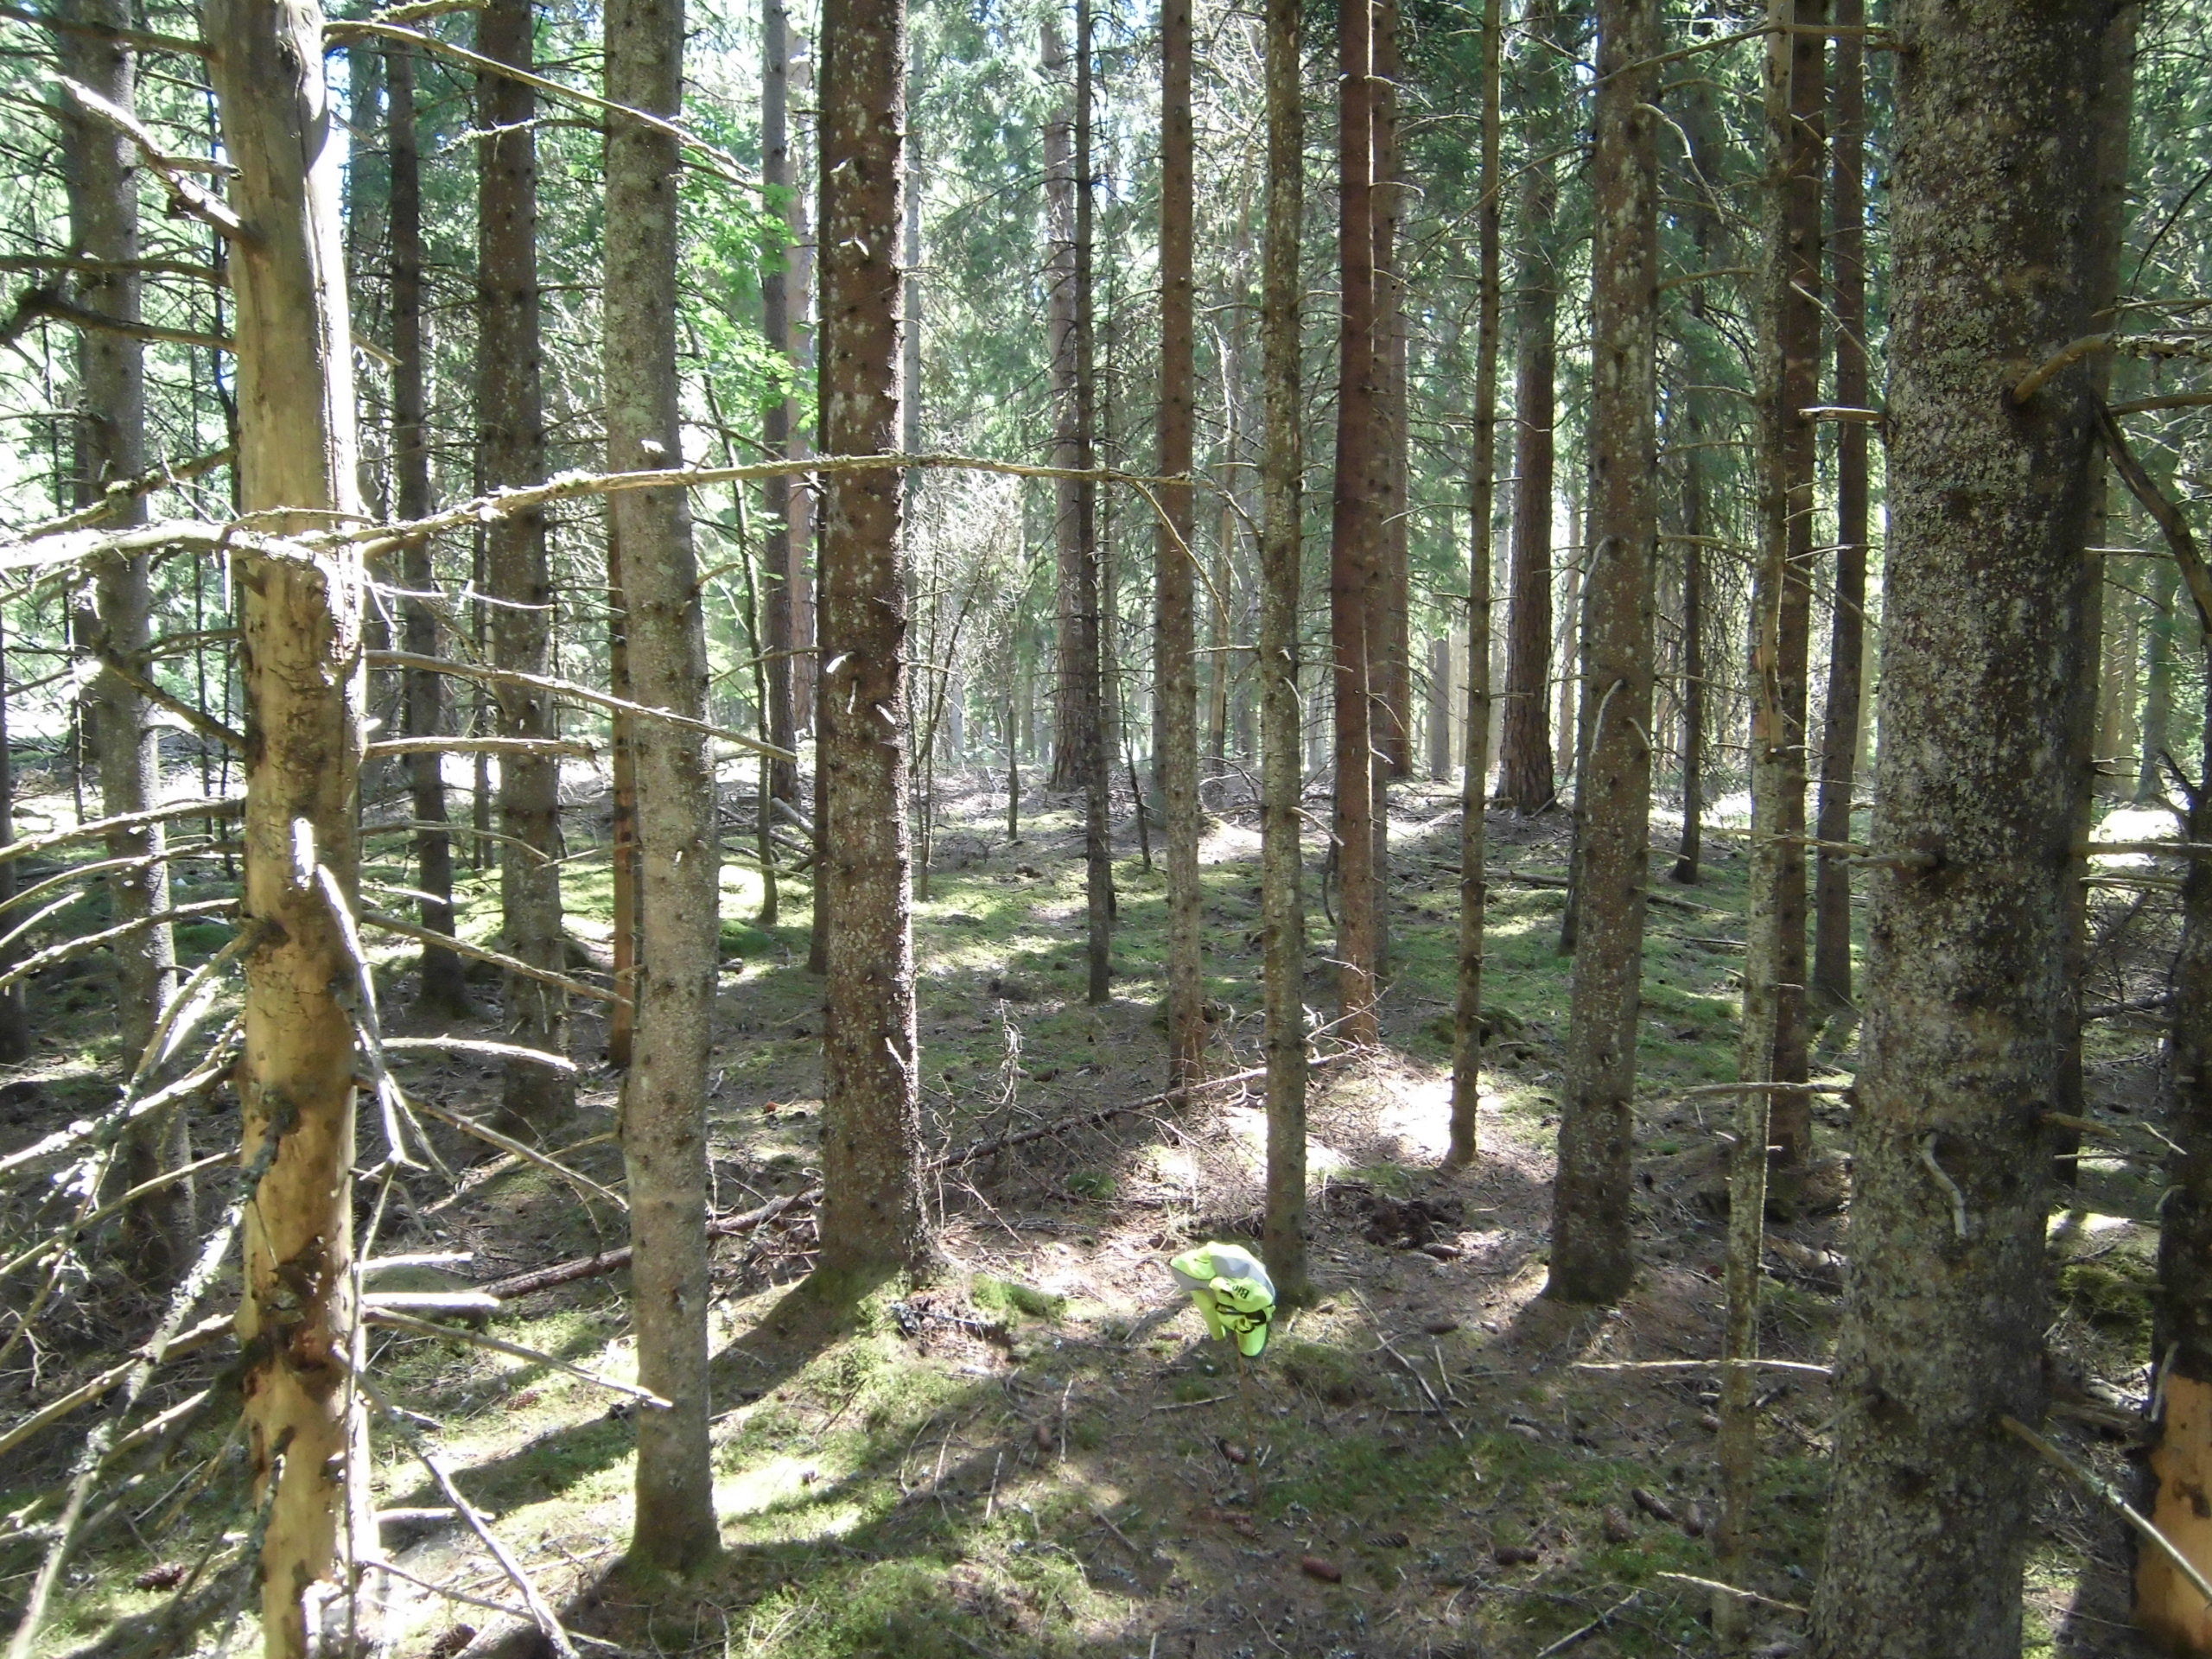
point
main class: Woodland
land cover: Spruce dominated coniferous woodland
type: boreal forest
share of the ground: 50 - 75 %
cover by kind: coniferous forest trees 65 %, lichens and mosses 20 %, unconsolidated bare surface 15 %
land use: Forestry
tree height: > 5 m
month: July
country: SE
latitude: 57.2717
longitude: 14.7227
